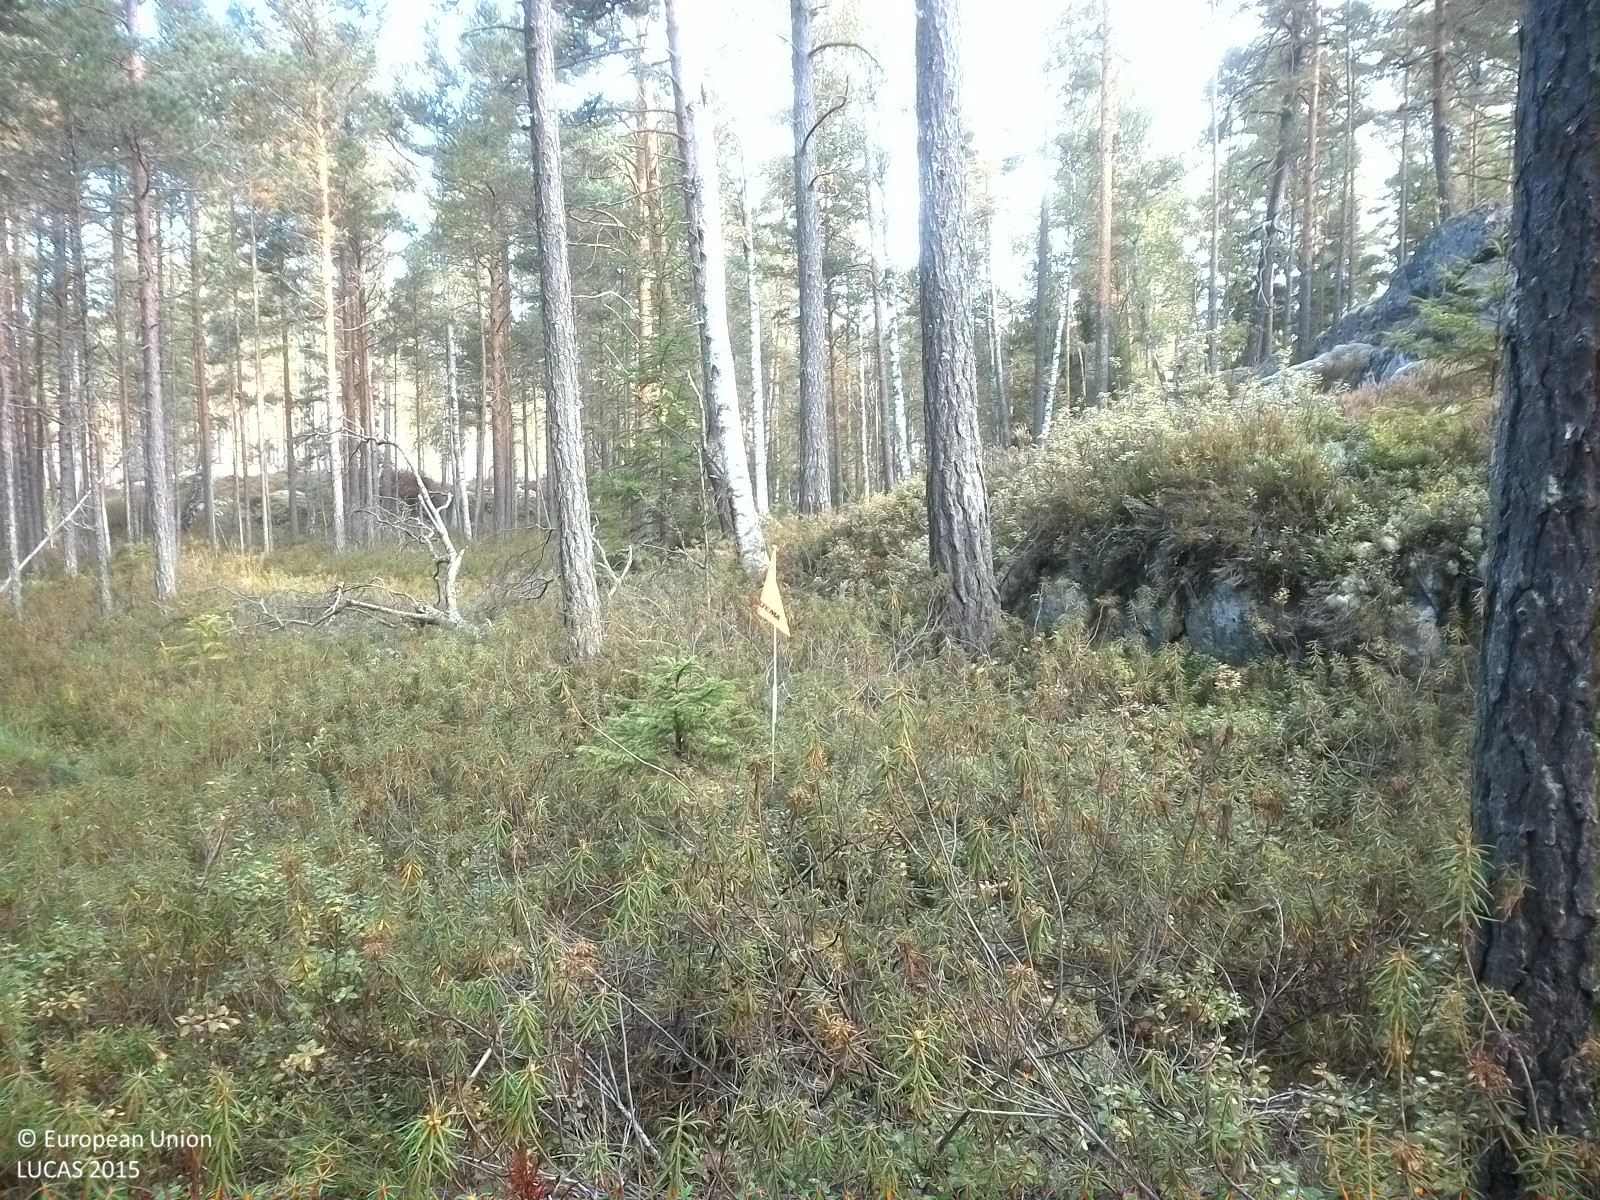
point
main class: Woodland
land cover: Pine dominated coniferous woodland
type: boreal forest
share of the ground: 10 - 25 %
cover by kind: shrubs 50 %, coniferous forest trees 20 %, lichens and mosses 20 %, herbaceous plants 10 %
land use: Forestry
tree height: > 5 m
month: September
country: SE
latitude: 58.9611
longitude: 15.7833
